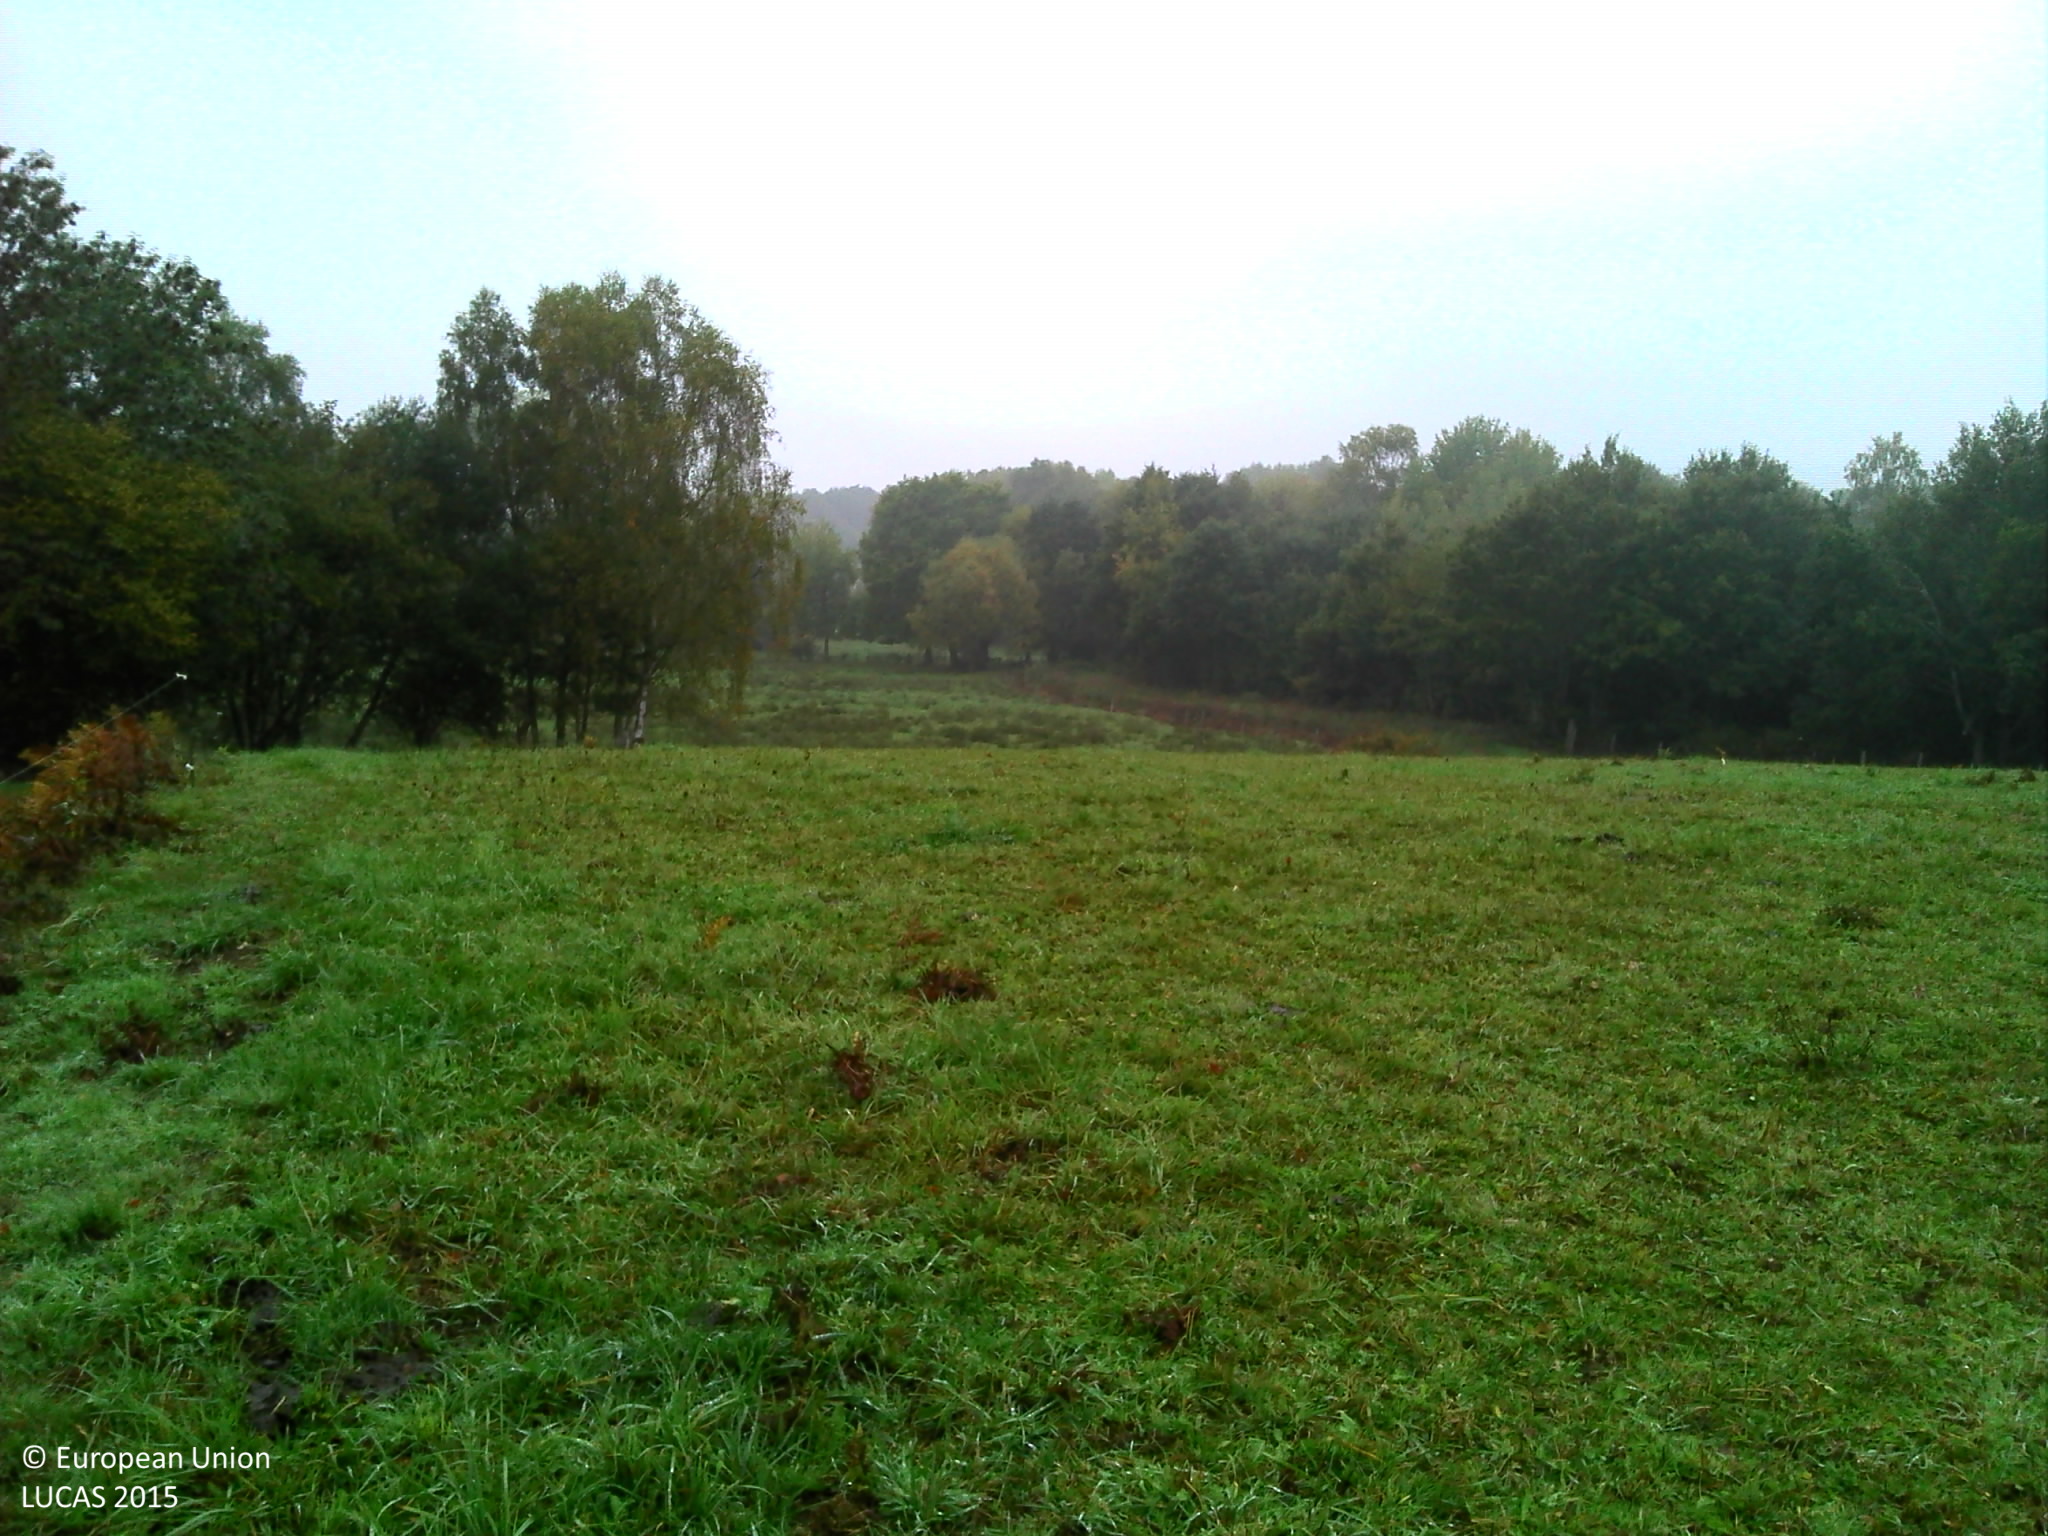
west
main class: Grassland
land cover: Grassland without tree/shrub cover
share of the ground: > 75 %
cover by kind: herbaceous plants 100 %
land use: Agriculture (excluding fallow land and kitchen gardens)
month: October
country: FR
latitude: 45.9500
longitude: 2.8642
